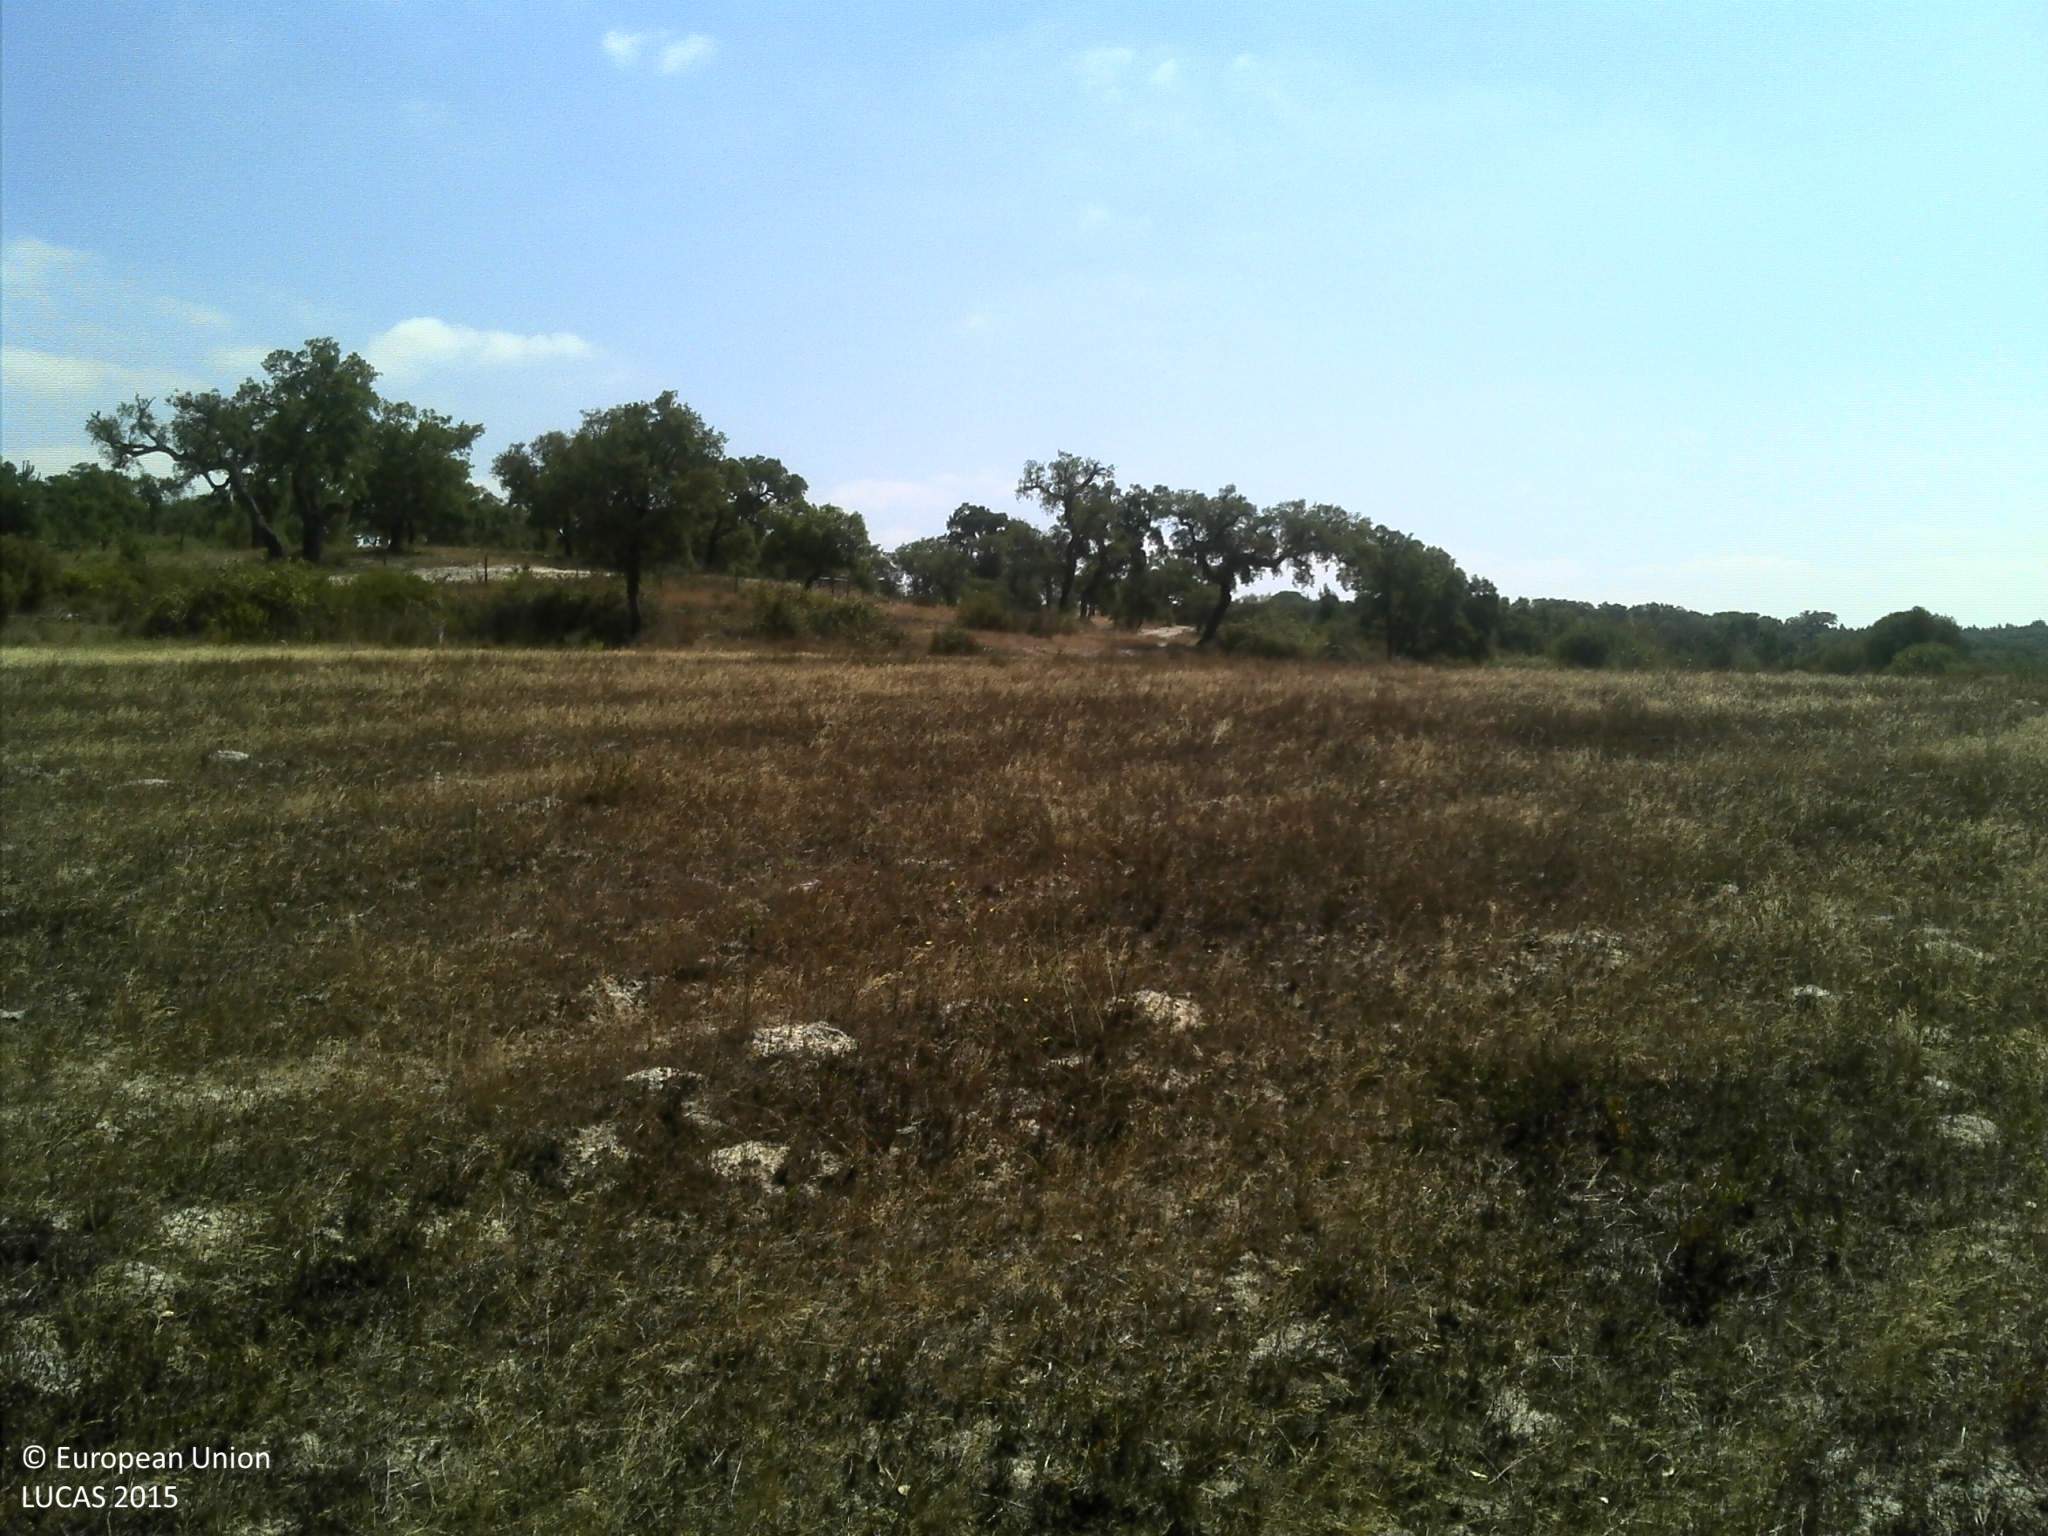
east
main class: Grassland
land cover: Grassland without tree/shrub cover
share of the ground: 25 - 50 %
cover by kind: unconsolidated bare surface 60 %, herbaceous plants 40 %
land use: Agriculture (excluding fallow land and kitchen gardens)
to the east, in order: Grassland without tree/shrub cover; Shrubland with sparse tree cover; Ditches and canals; Shrubland with sparse tree cover
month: July
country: PT
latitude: 39.0643
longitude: -8.3078
